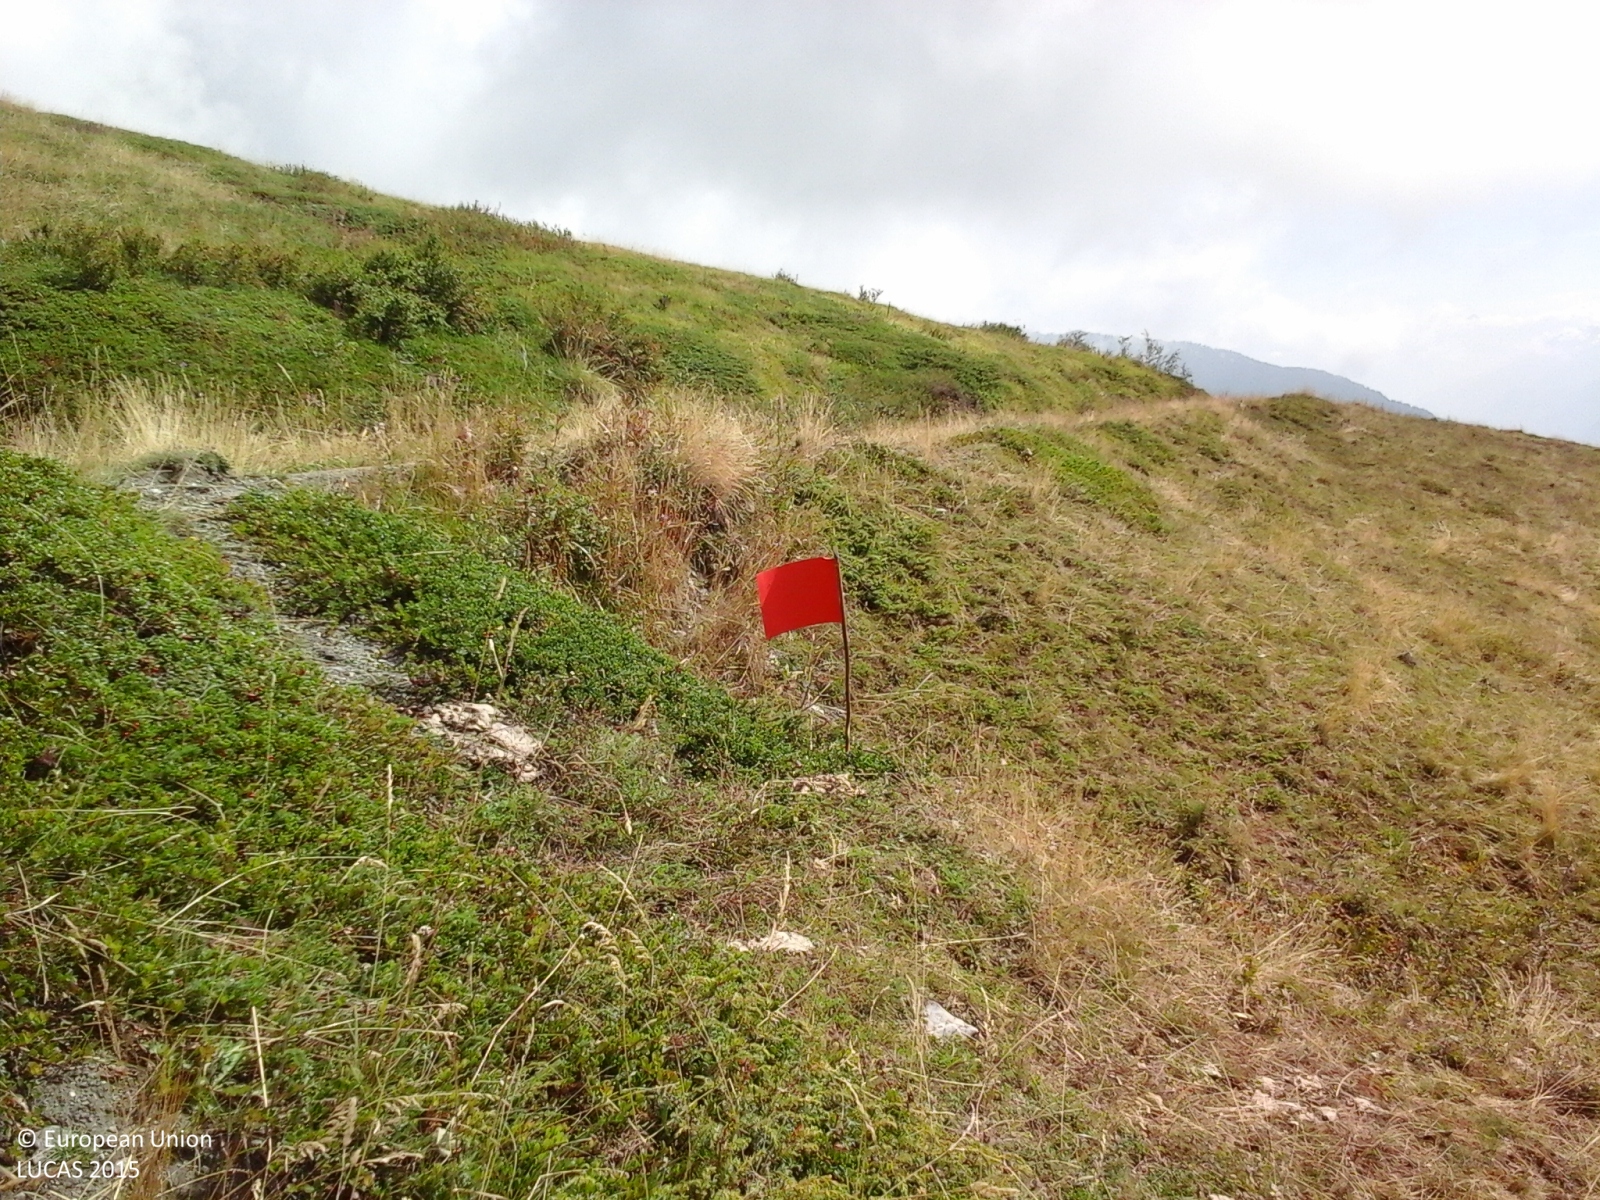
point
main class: Grassland
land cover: Grassland without tree/shrub cover
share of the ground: > 75 %
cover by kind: herbaceous plants 100 %
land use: Agriculture (excluding fallow land and kitchen gardens)
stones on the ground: < 10 %
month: August
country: IT
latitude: 45.7368
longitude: 7.1636
